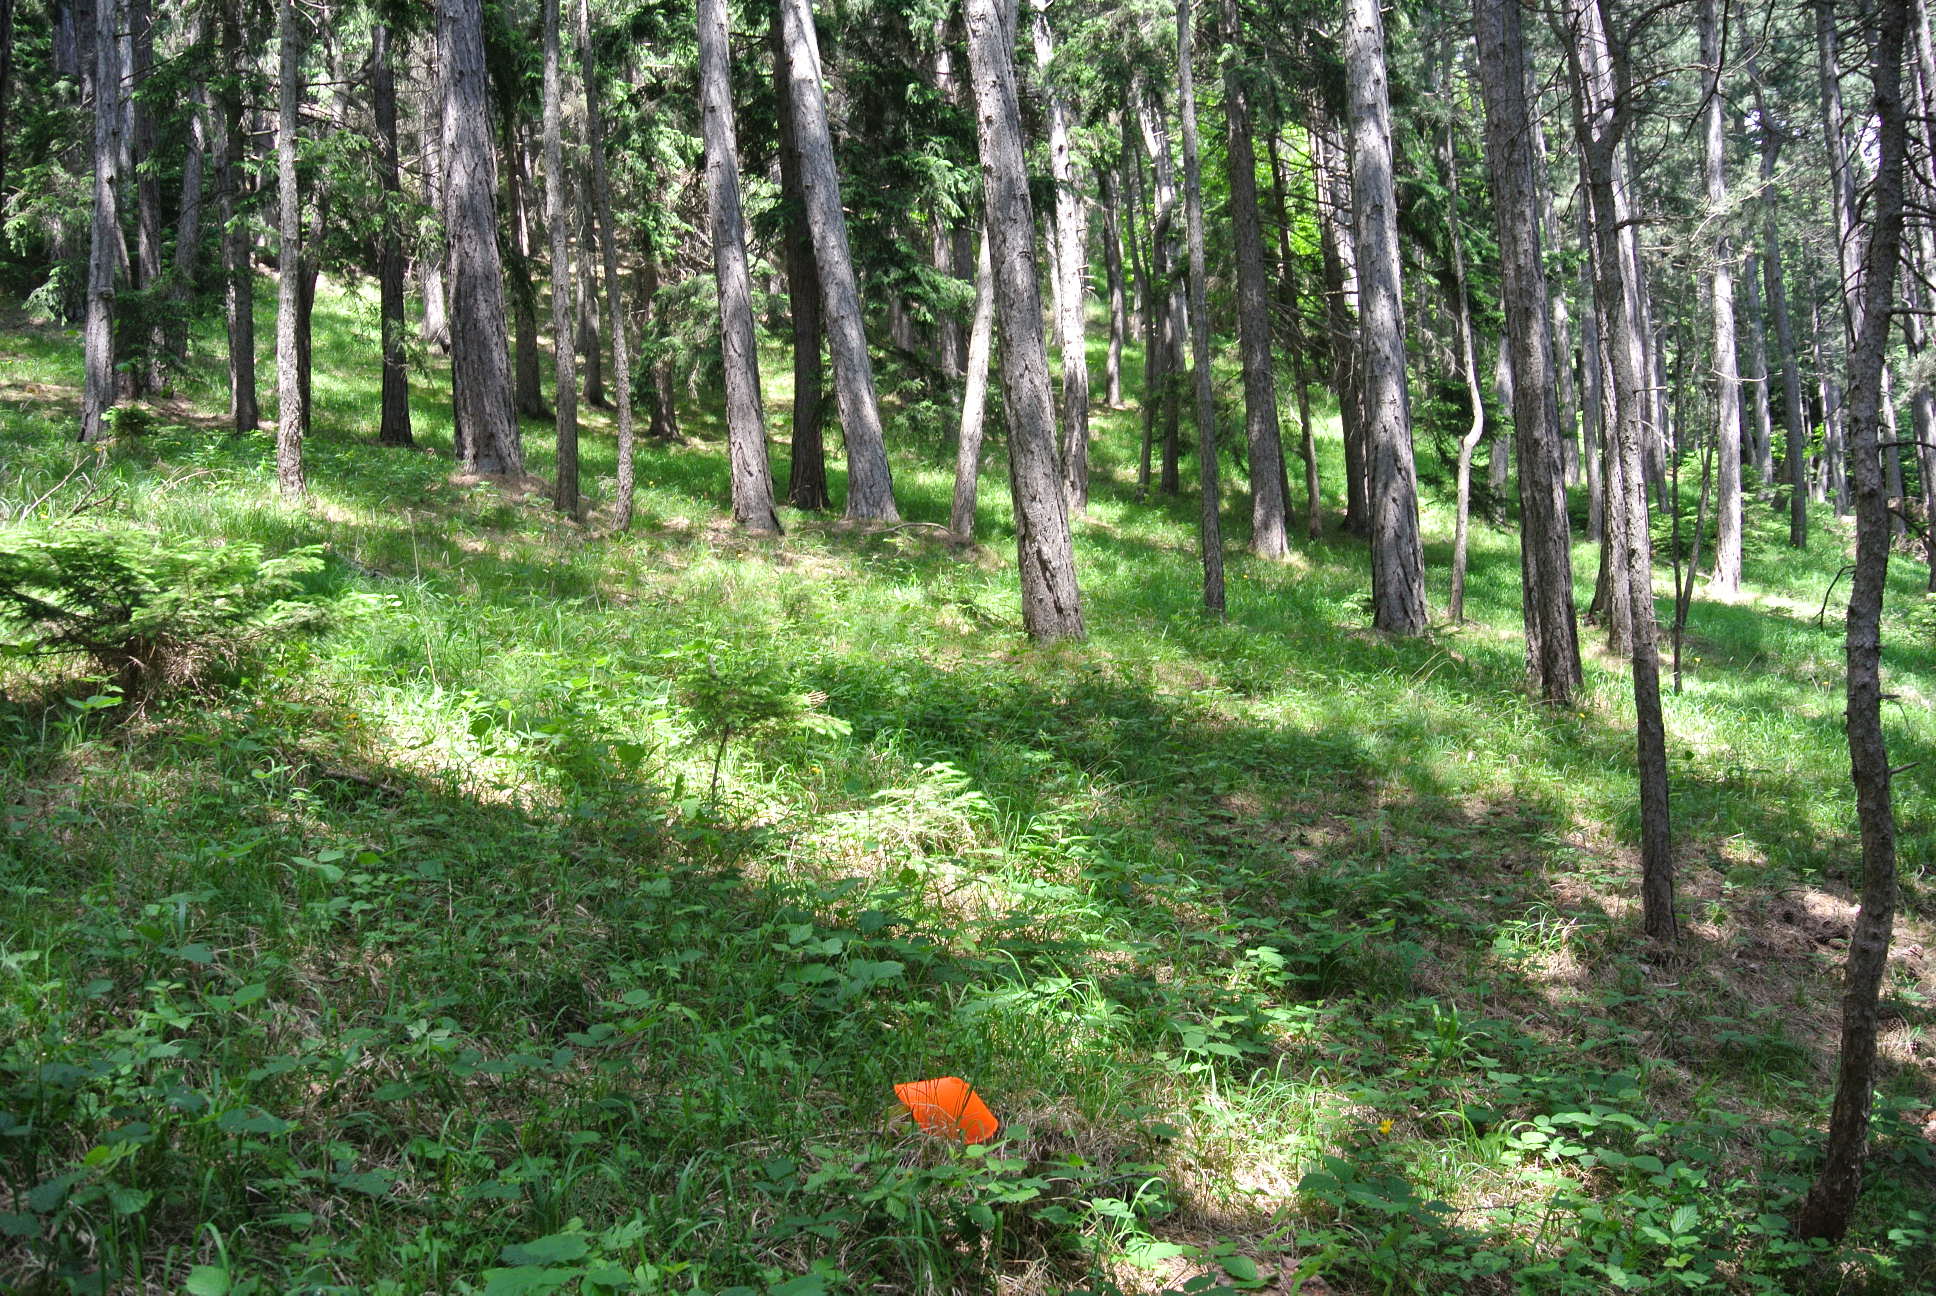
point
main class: Woodland
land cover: Pine dominated coniferous woodland
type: alpine coniferous forest
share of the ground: > 75 %
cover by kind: coniferous forest trees 85 %, herbaceous plants 15 %
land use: Forestry
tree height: > 5 m
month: May
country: AT
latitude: 47.8061
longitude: 16.0251
